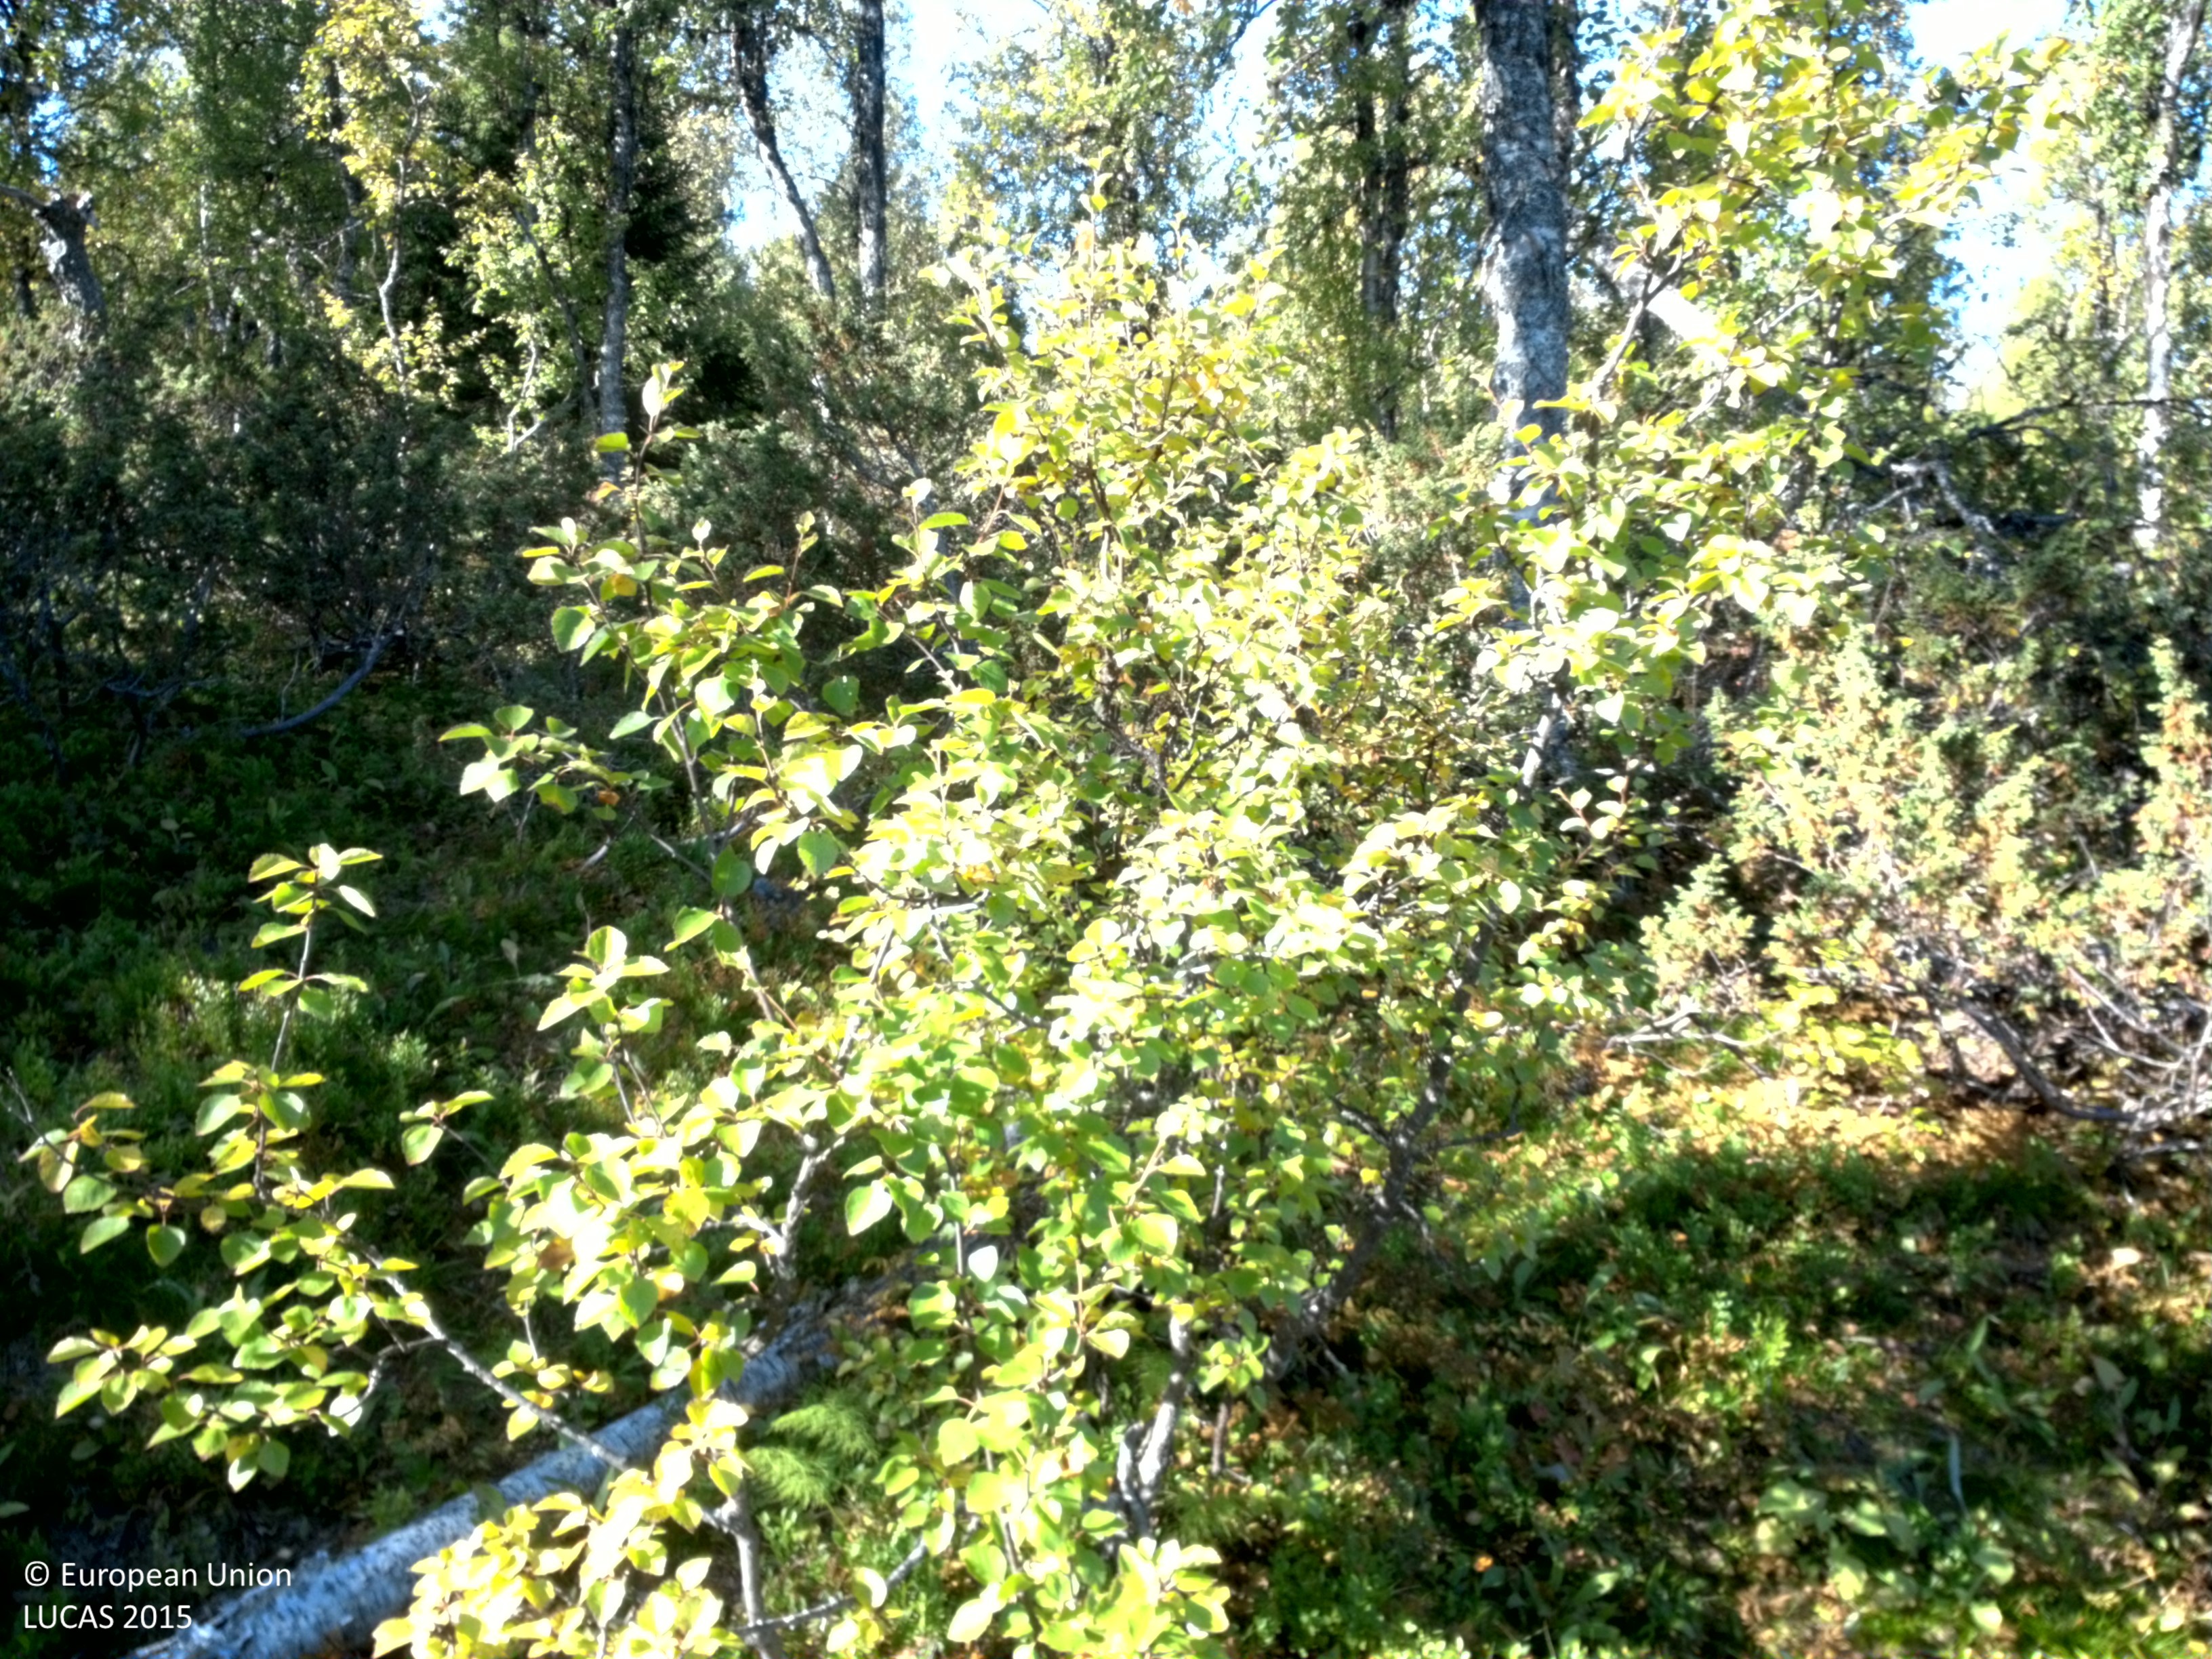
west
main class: Woodland
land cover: Broadleaved woodland
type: non-riverine alder, birch or aspen forest
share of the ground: 10 - 25 %
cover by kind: shrubs 50 %, herbaceous plants 30 %, broadleaved forest trees 15 %, lichens and mosses 5 %
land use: Amenities, museums, leisure
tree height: > 5 m
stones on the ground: < 10 %
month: September
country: SE
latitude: 65.8461
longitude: 16.4202
